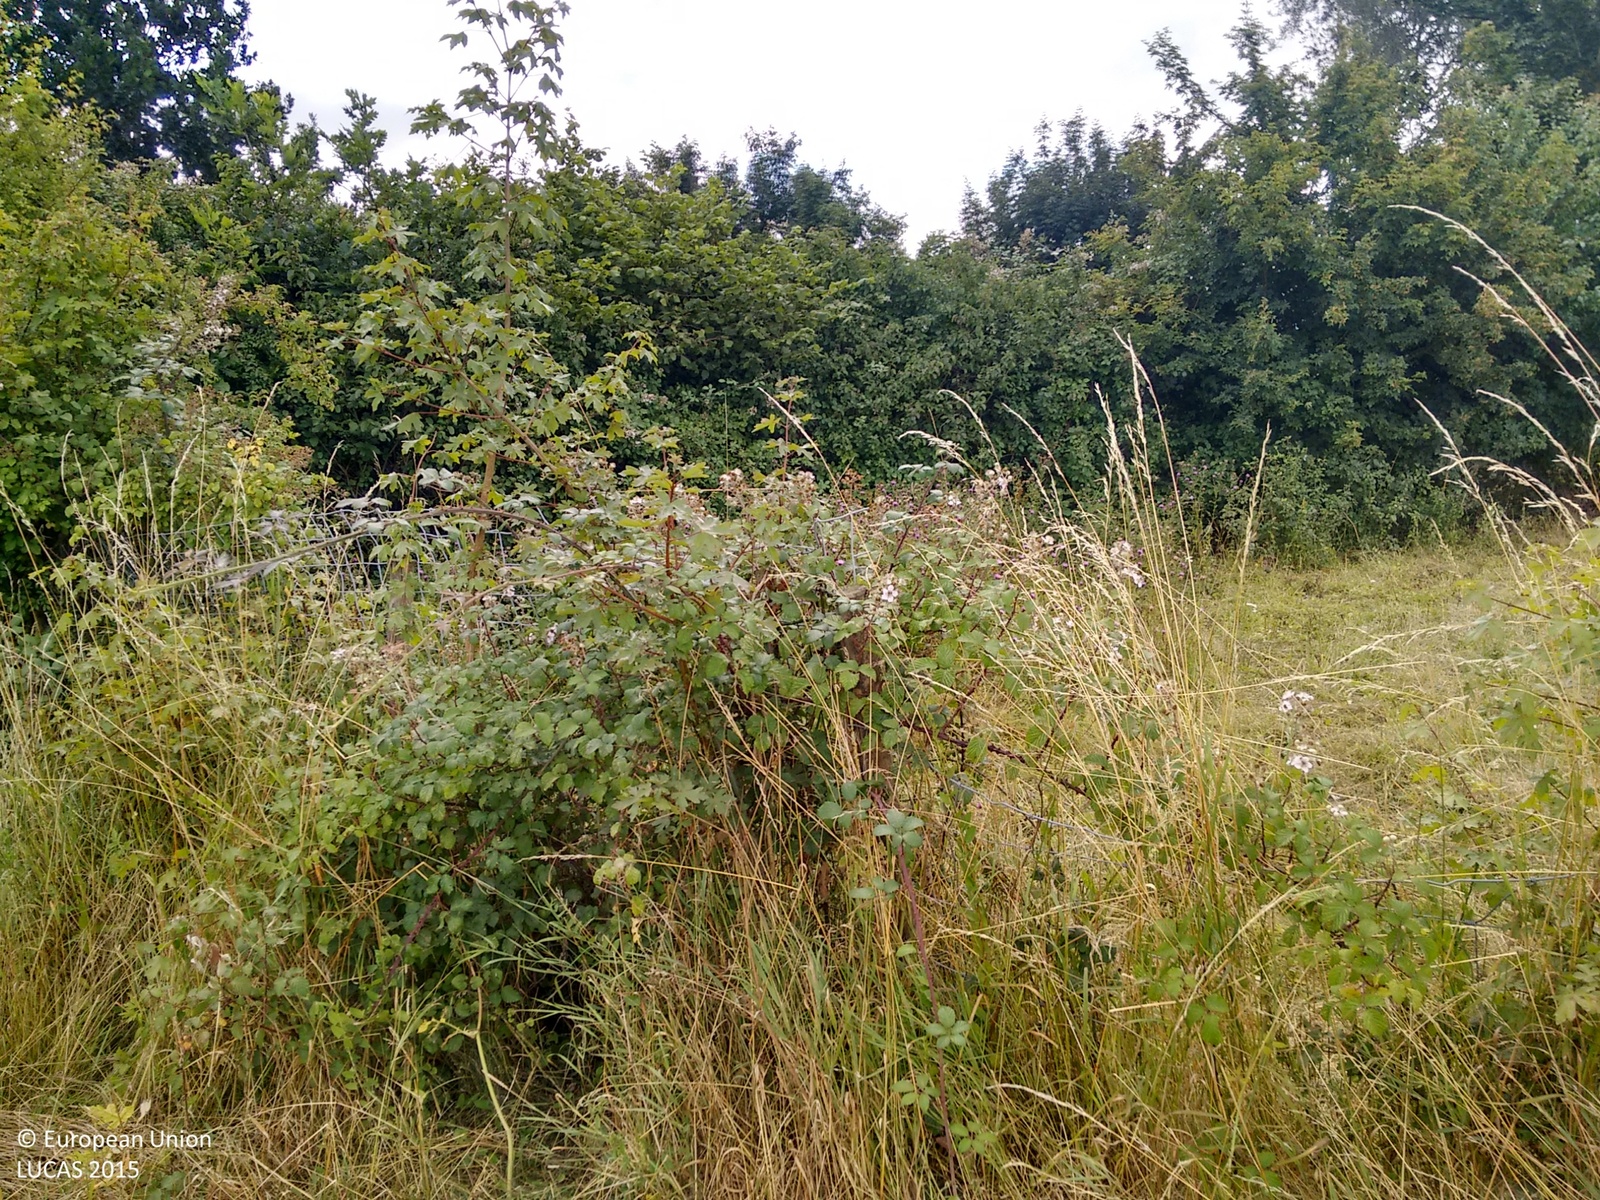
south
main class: Grassland
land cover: Grassland without tree/shrub cover
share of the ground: > 75 %
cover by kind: herbaceous plants 100 %
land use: Agriculture (excluding fallow land and kitchen gardens)
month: August
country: GB
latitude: 51.9678
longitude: 0.3791
